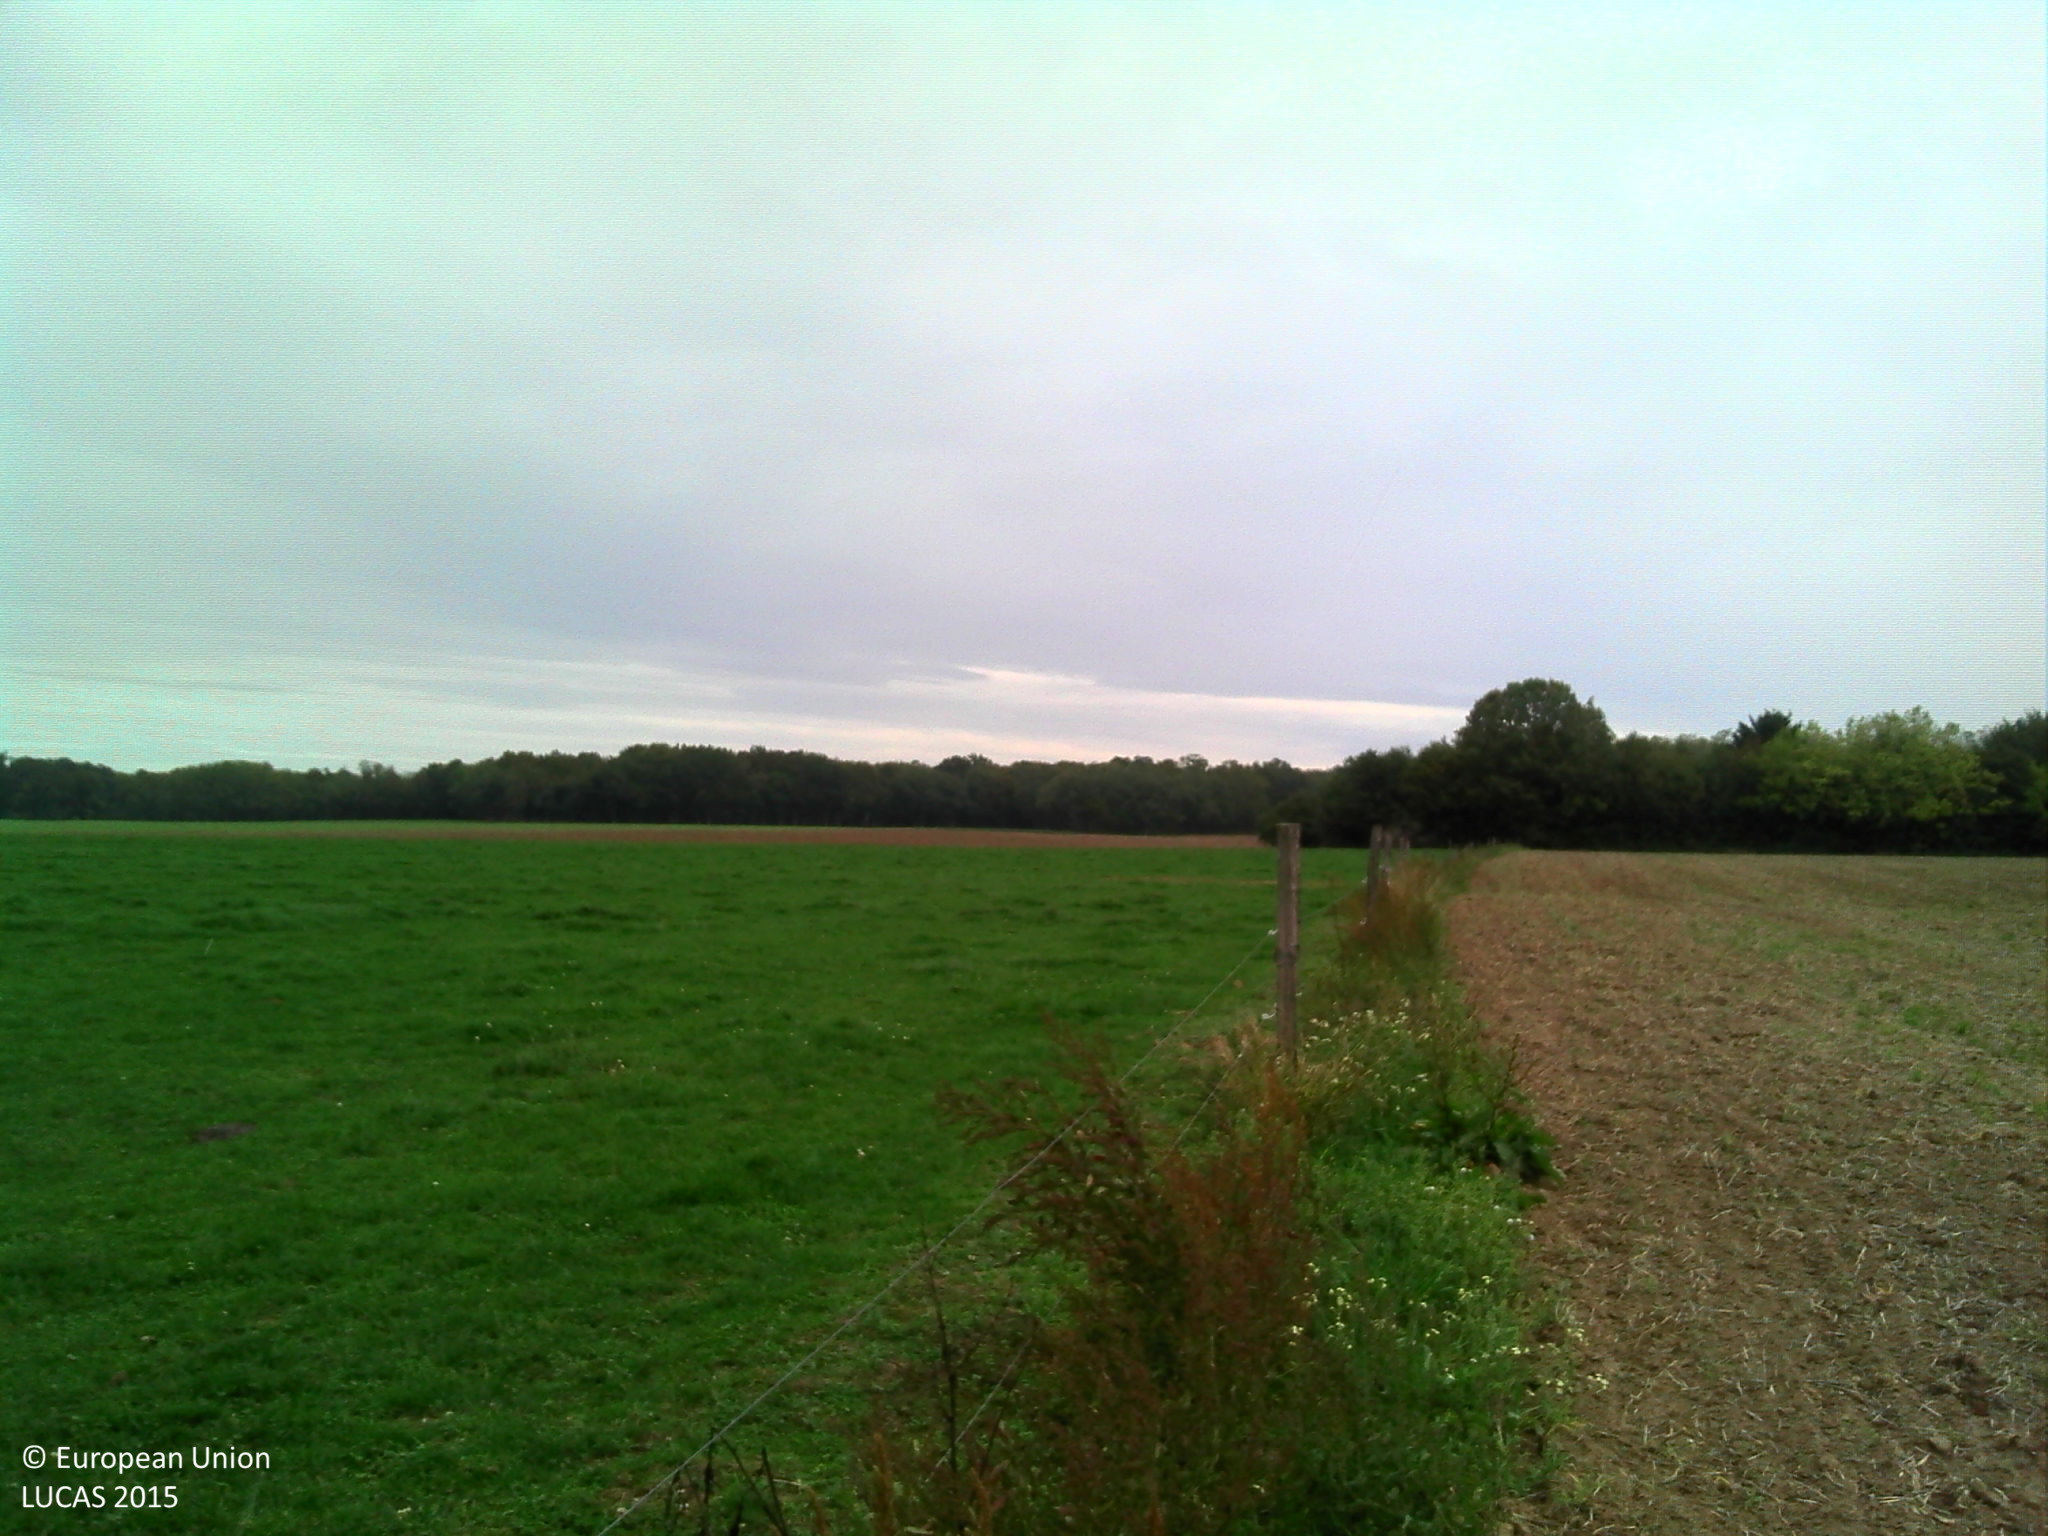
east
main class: Cropland
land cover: Temporary grasslands
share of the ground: > 75 %
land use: Agriculture (excluding fallow land and kitchen gardens)
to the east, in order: Temporary grasslands; Fences; Tracks; Grass margins; Ditches and canals; Maize
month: October
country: FR
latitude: 46.4863
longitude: 4.9867
